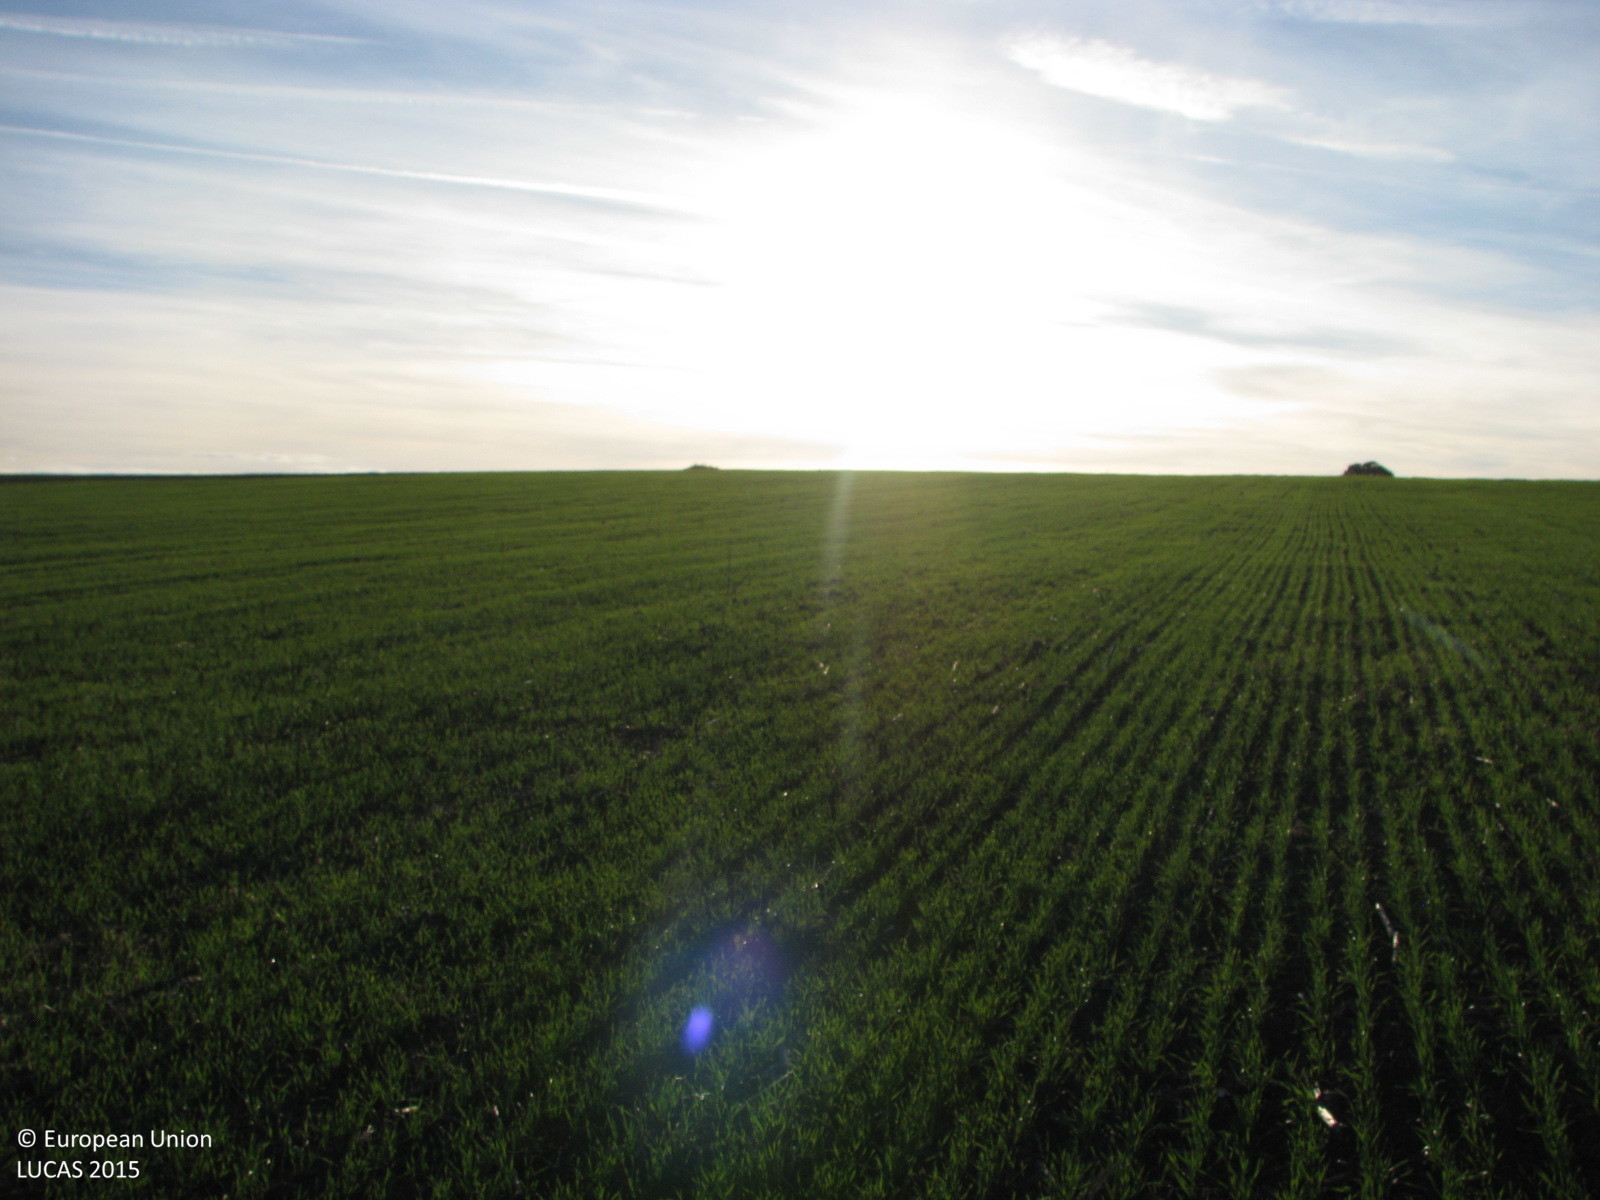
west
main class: Cropland
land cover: Common wheat
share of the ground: > 75 %
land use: Agriculture (excluding fallow land and kitchen gardens)
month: October
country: BG
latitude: 42.2847
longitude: 26.8204
